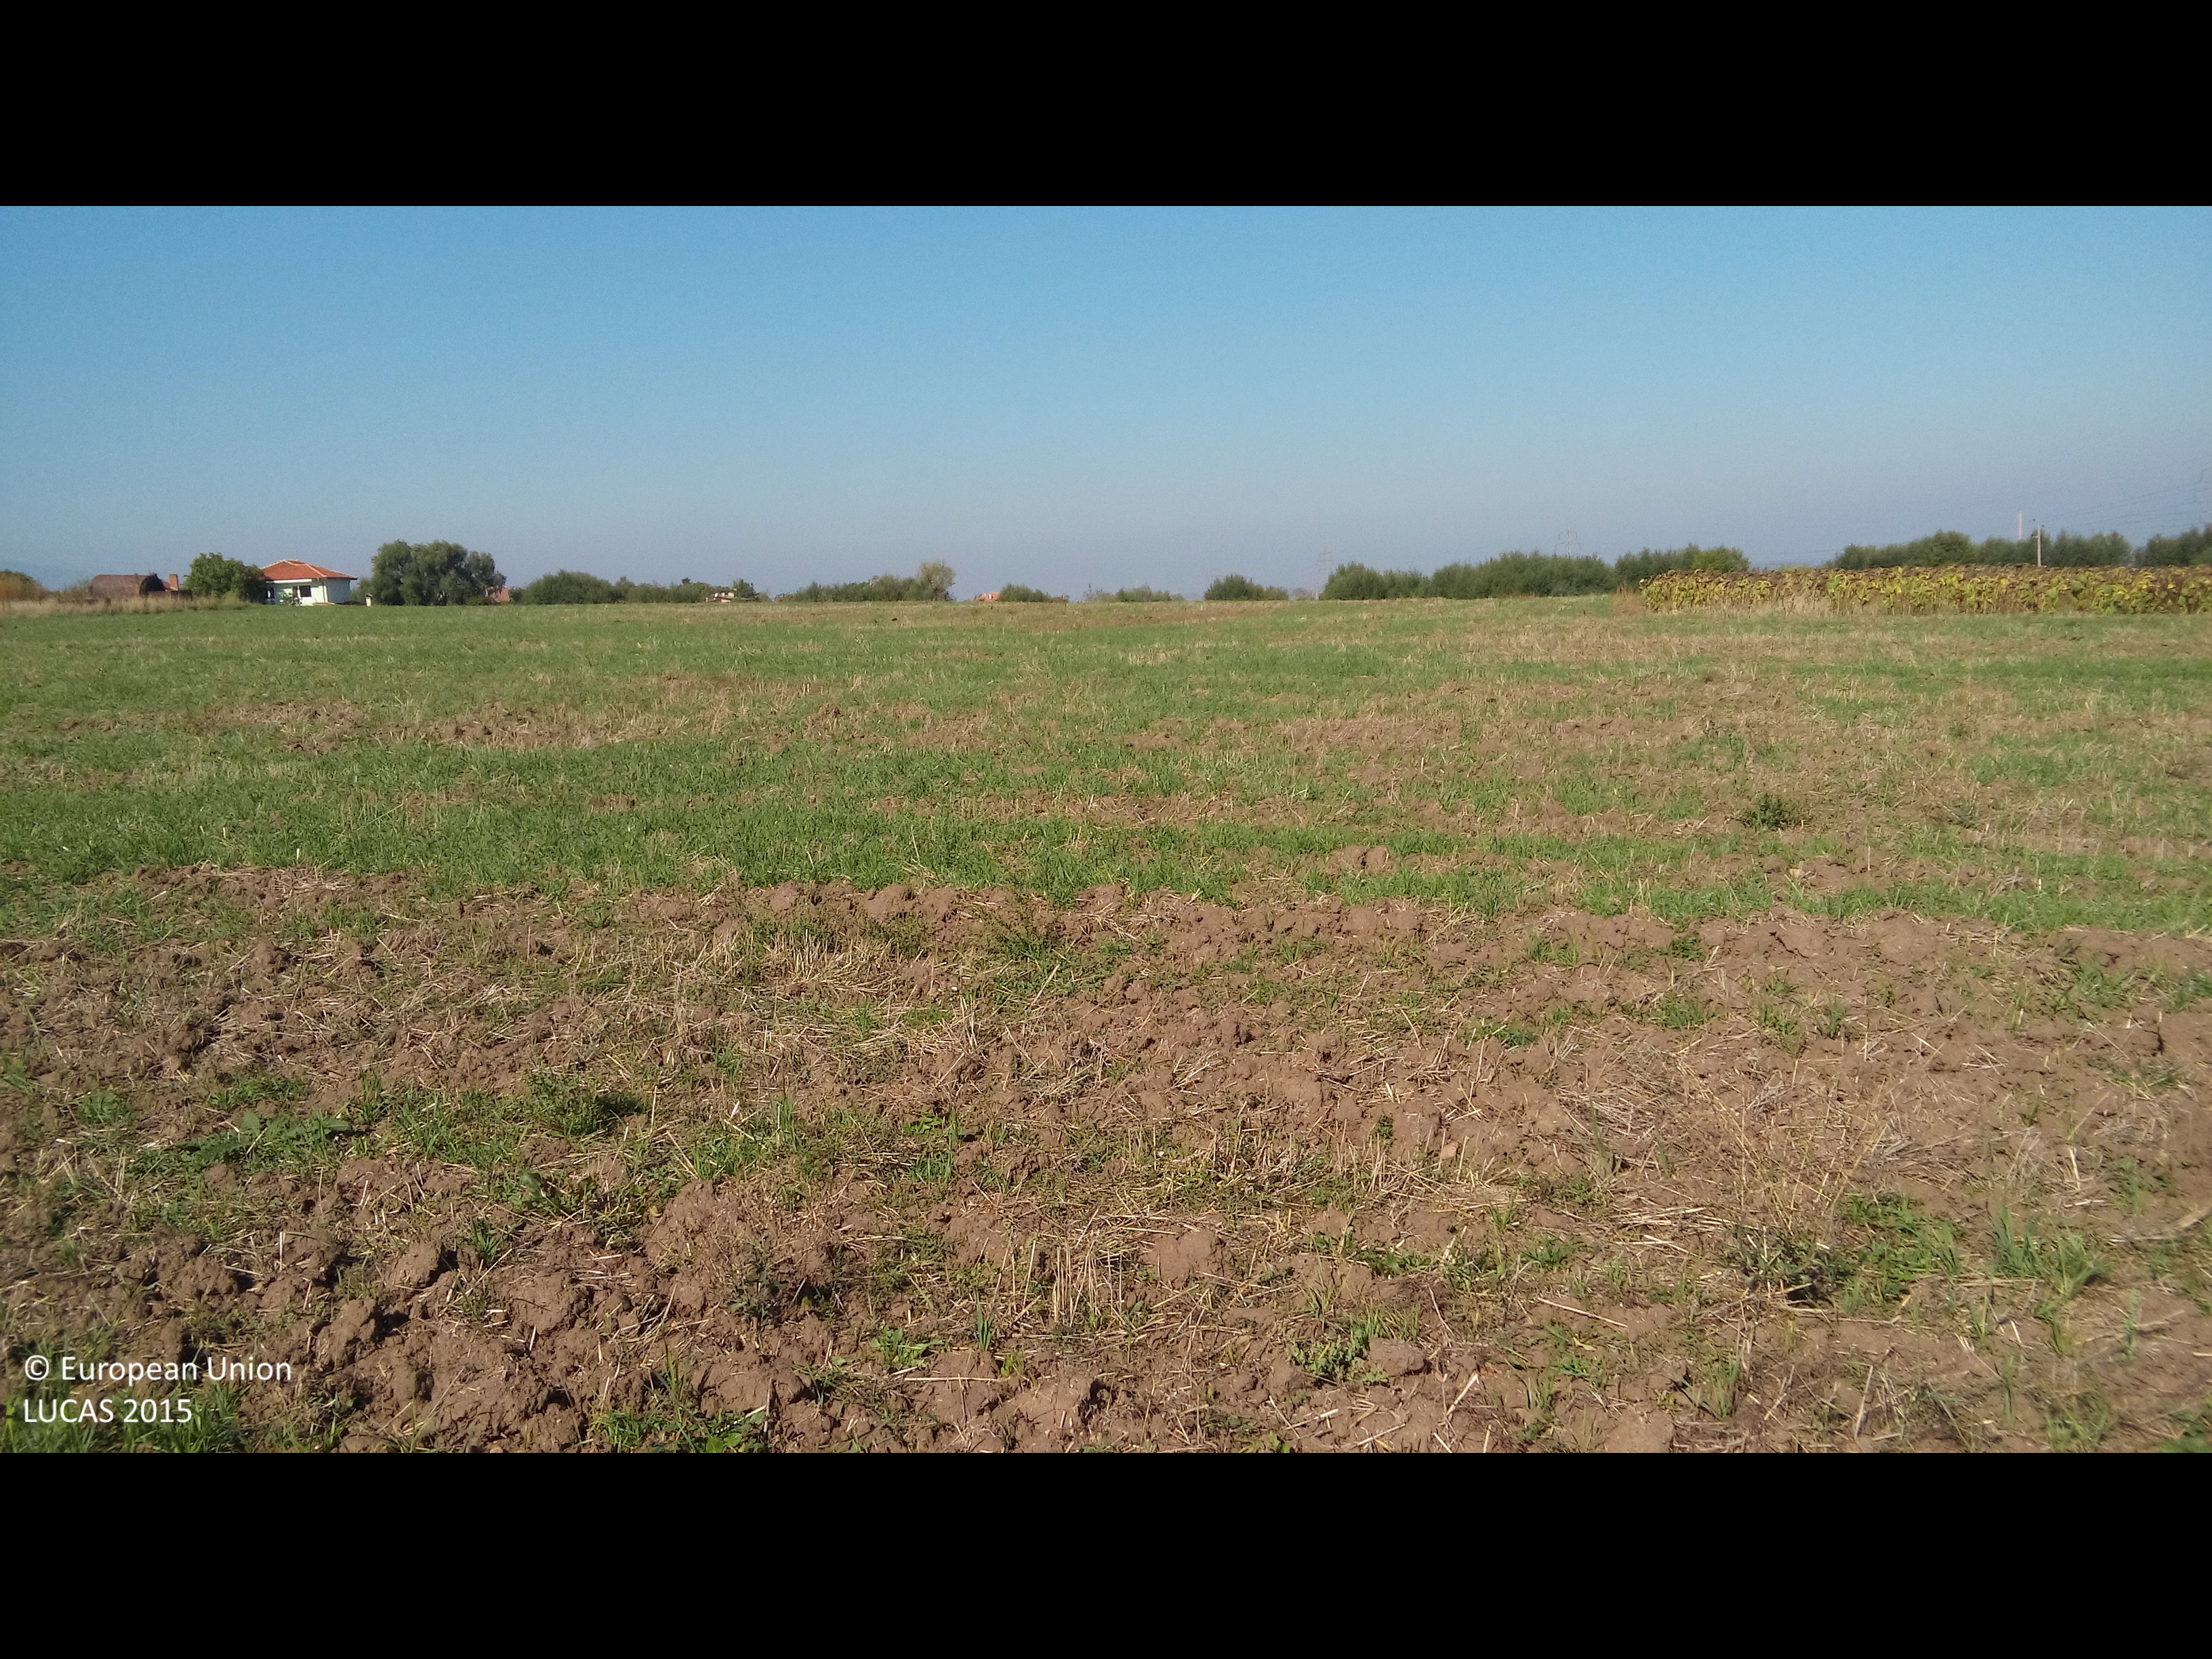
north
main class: Cropland
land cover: Common wheat
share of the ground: < 10 %
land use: Agriculture (excluding fallow land and kitchen gardens)
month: October
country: BG
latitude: 42.6090
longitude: 23.6047
